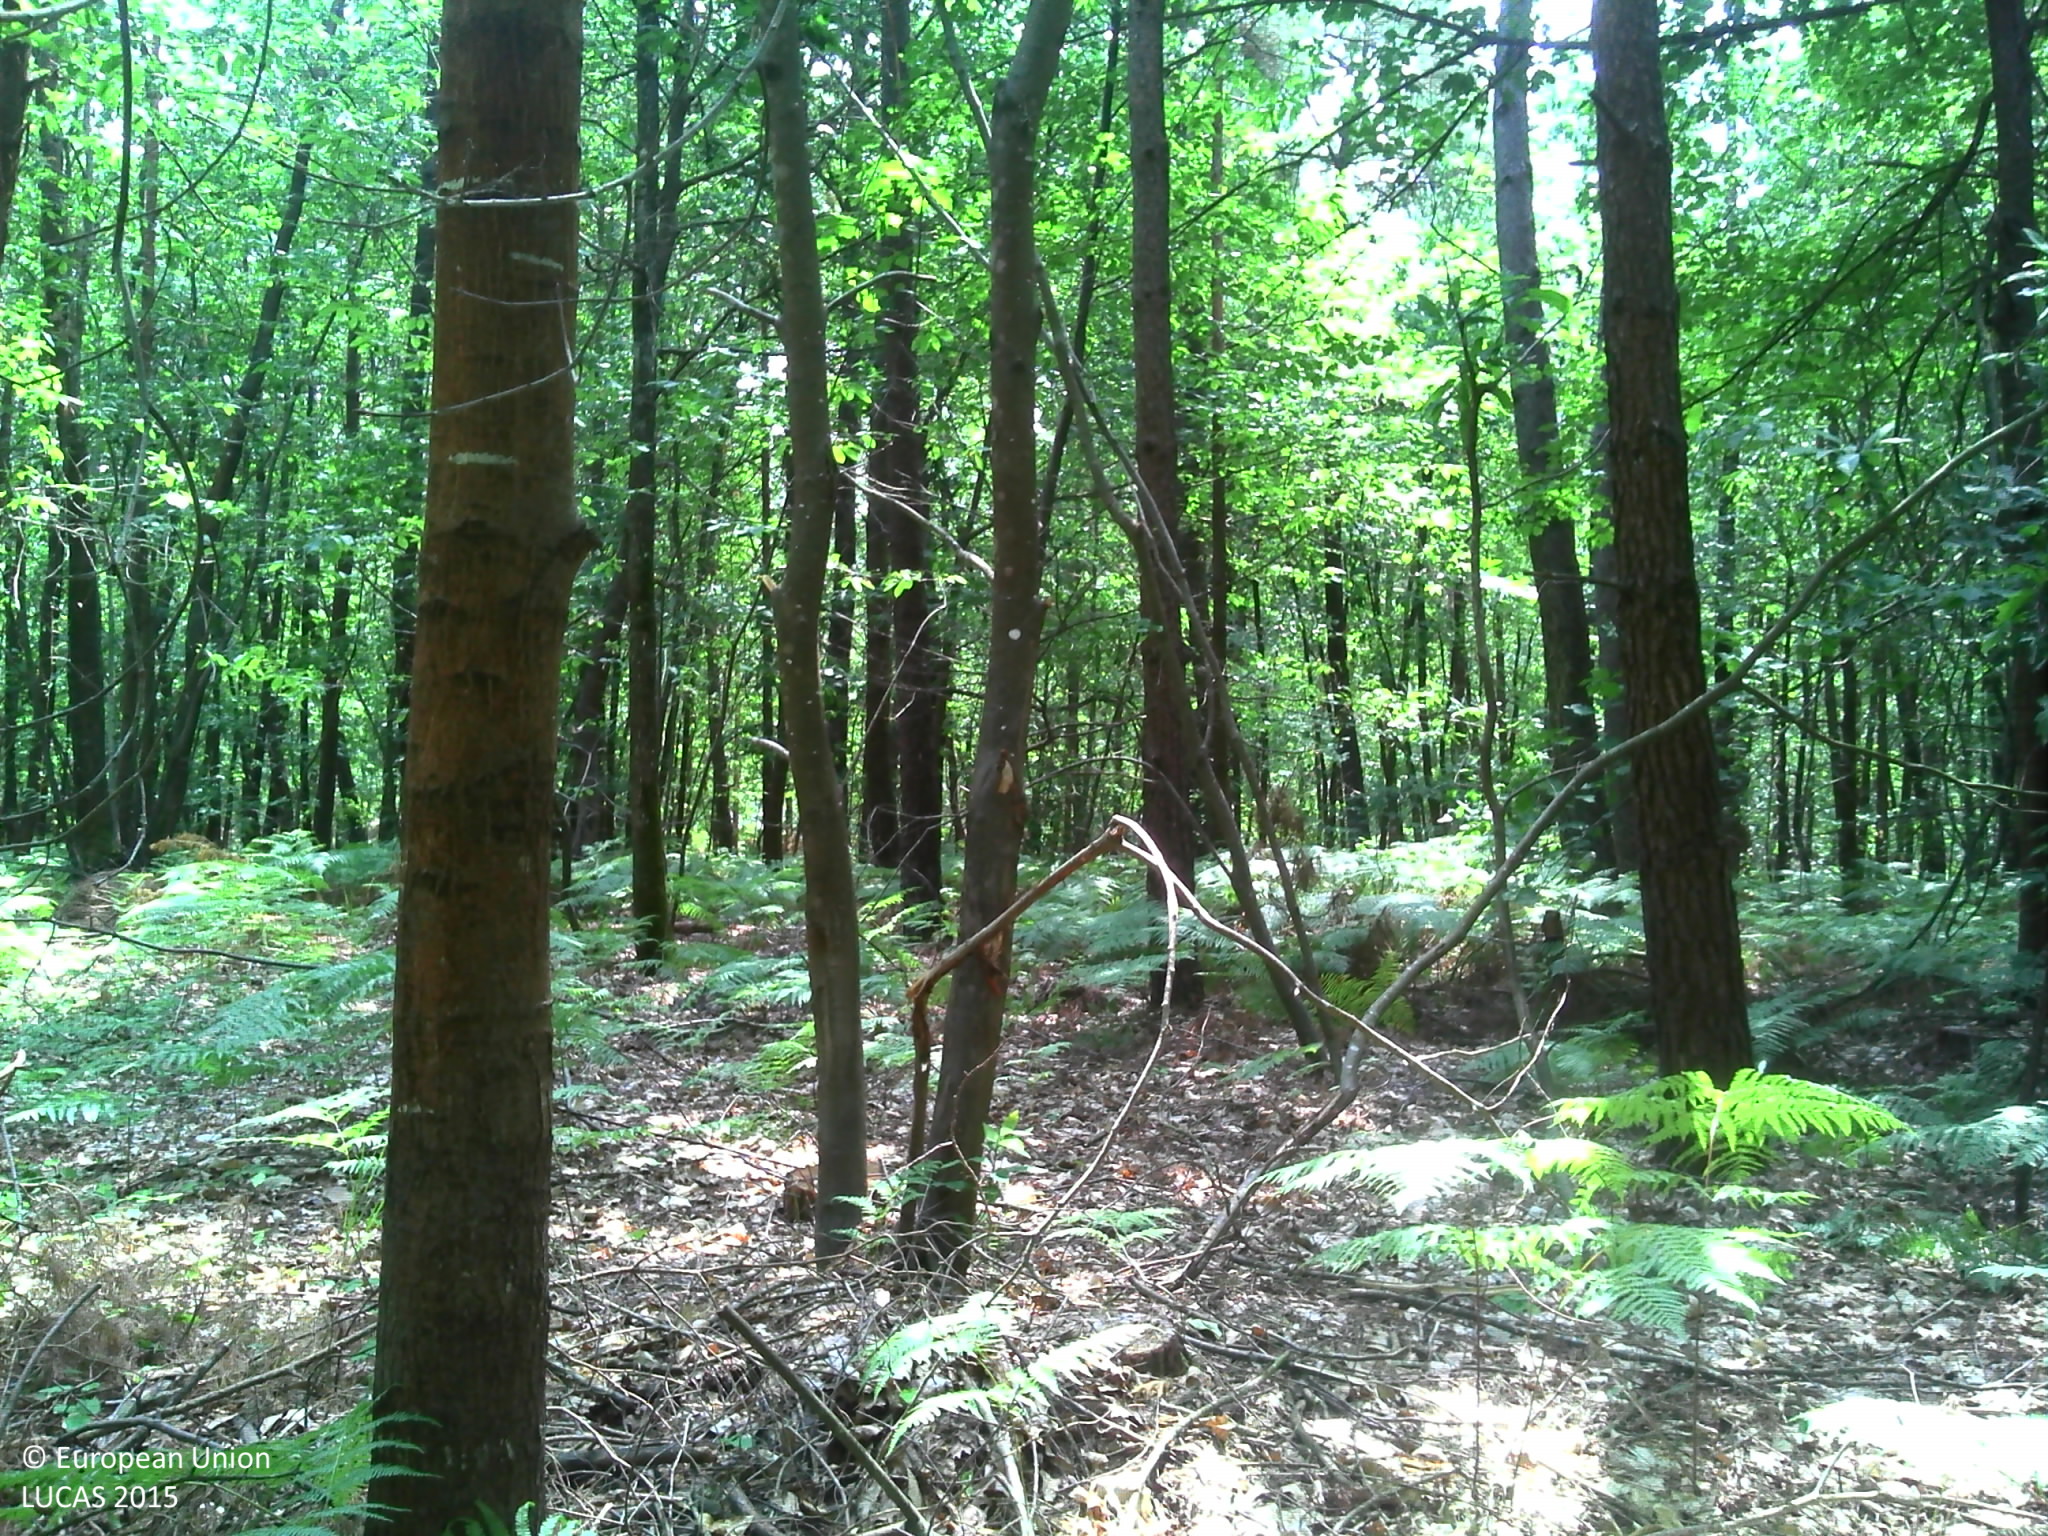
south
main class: Woodland
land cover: Pine dominated mixed woodland
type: hemiboreal forest and nemoral coniferous forest and mixed broadleaved-coniferous forest
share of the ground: > 75 %
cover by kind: broadleaved forest trees 50 %, coniferous forest trees 25 %, herbaceous plants 15 %, shrubs 10 %
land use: Forestry
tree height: > 5 m
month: July
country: FR
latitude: 47.7435
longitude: 0.3336
